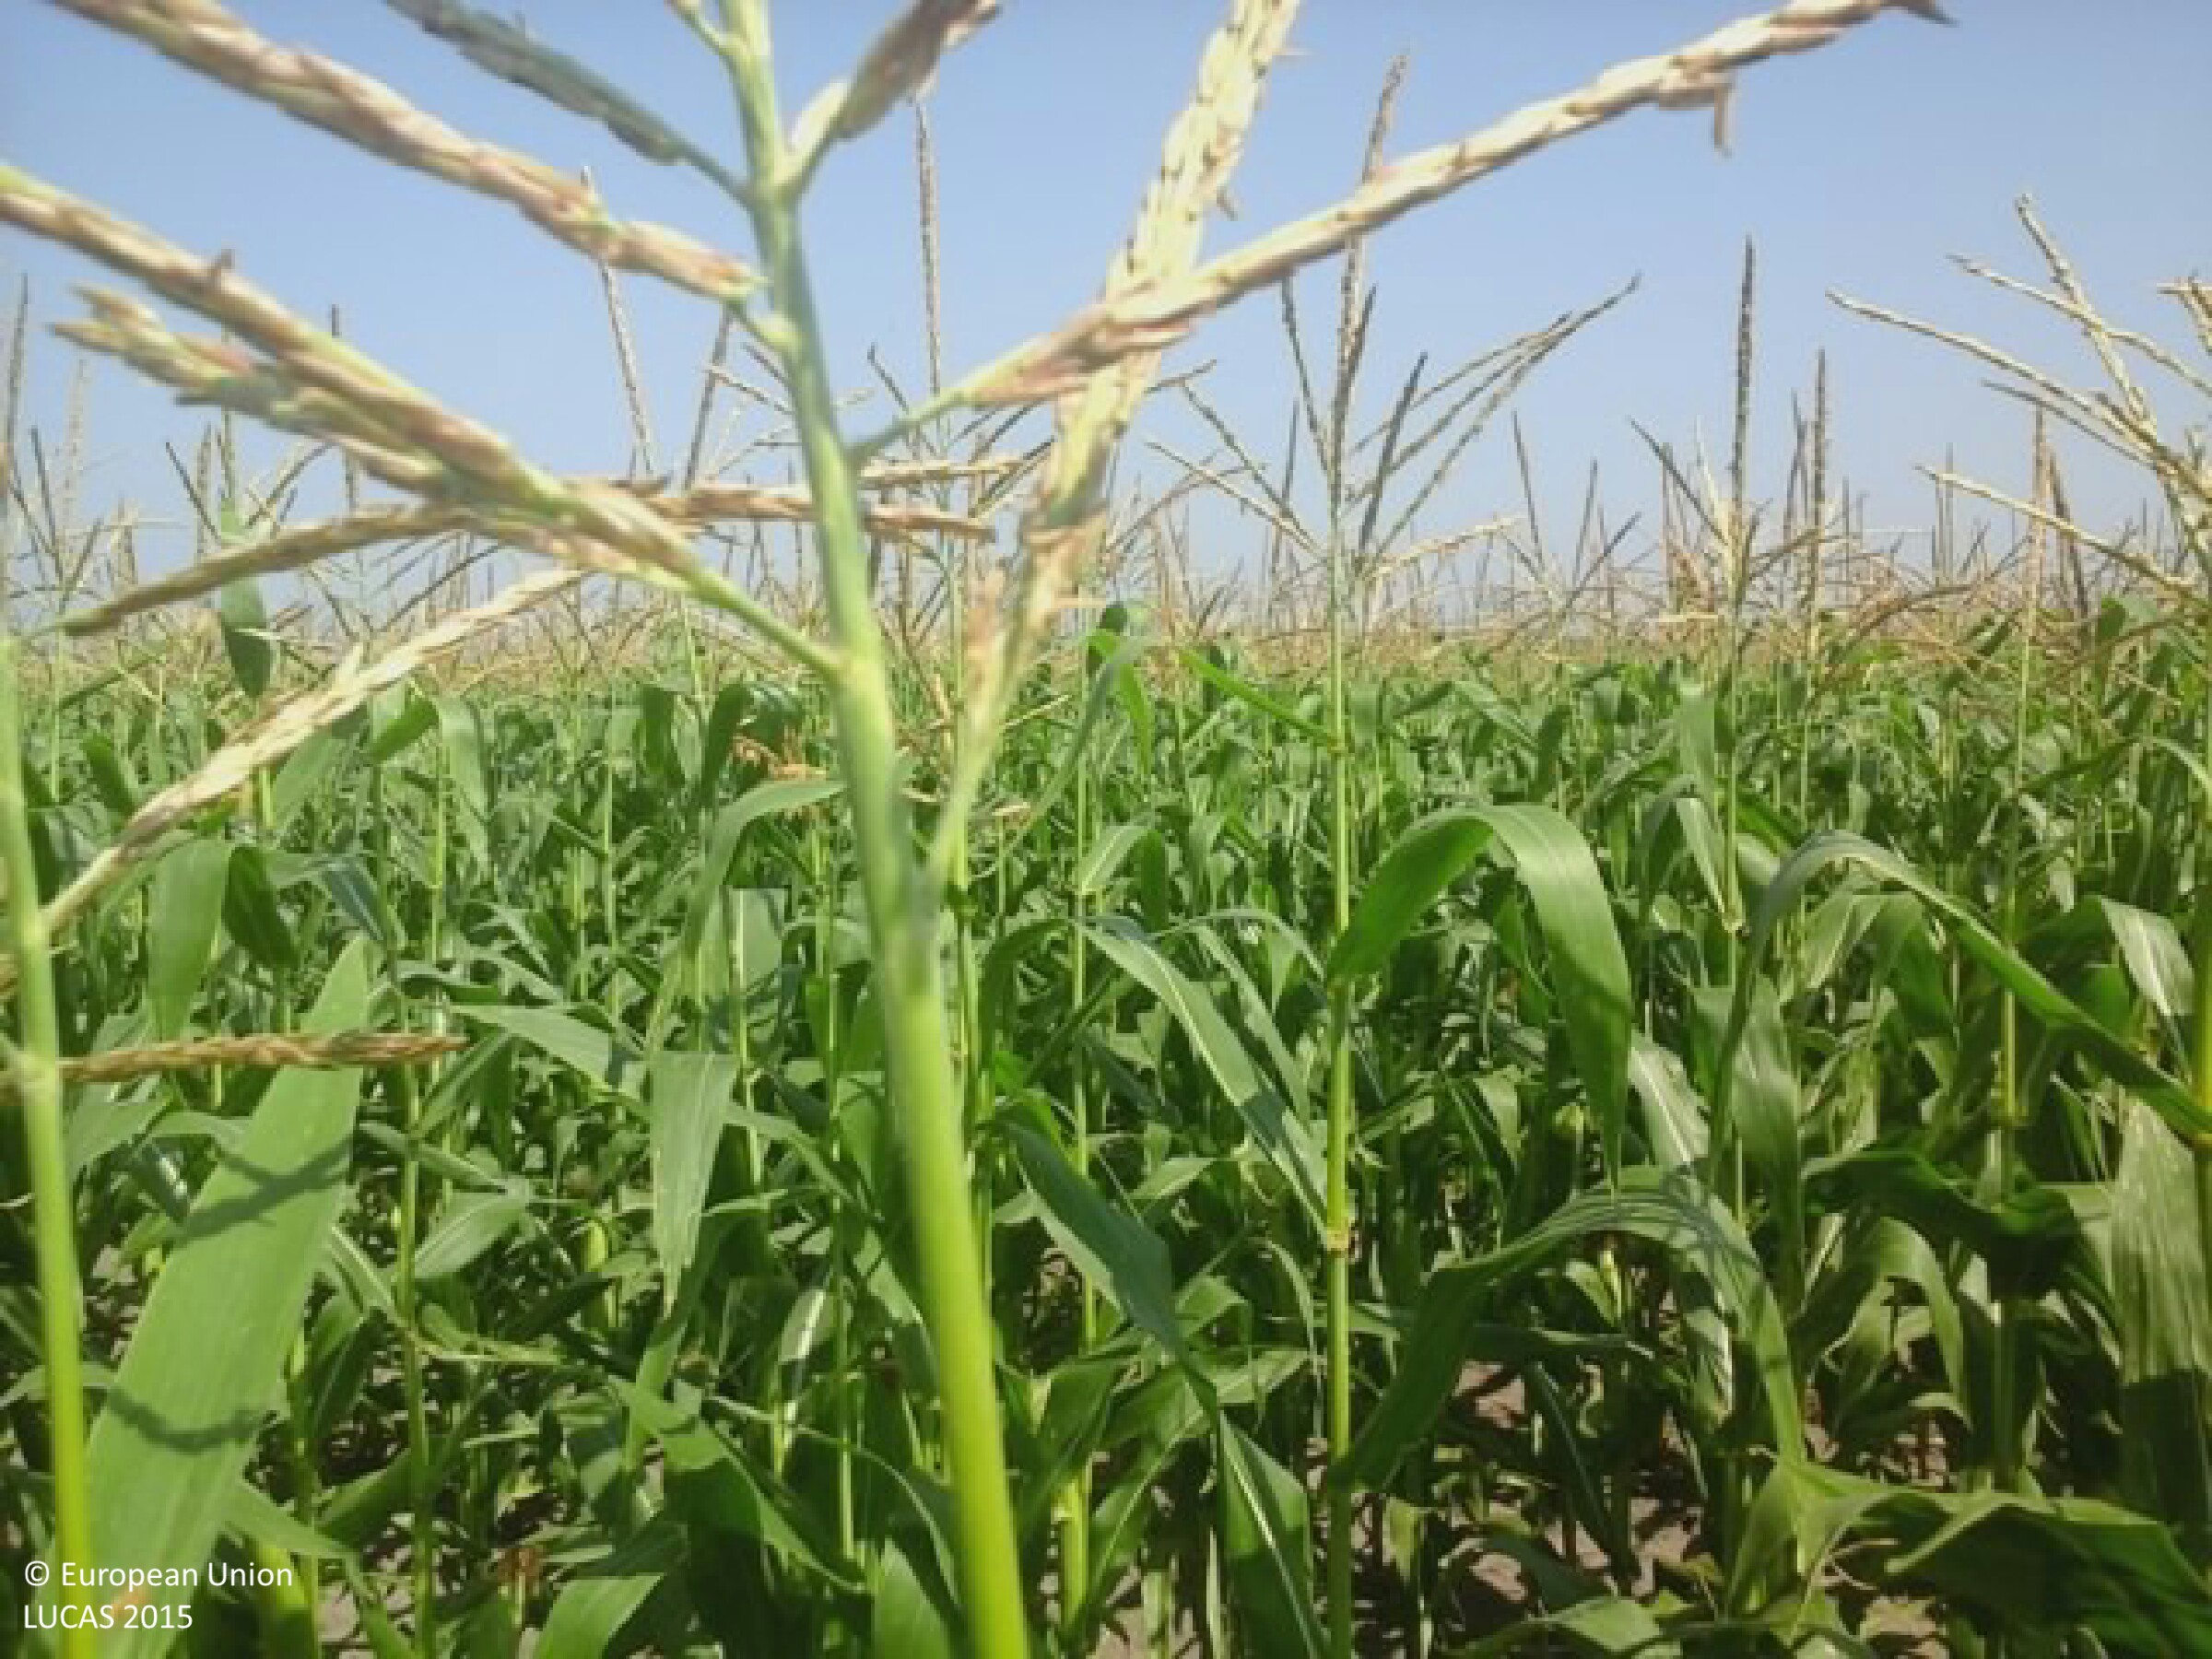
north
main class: Cropland
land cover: Maize
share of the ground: > 75 %
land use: Agriculture (excluding fallow land and kitchen gardens)
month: August
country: HU
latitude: 47.1290
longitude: 19.2326
